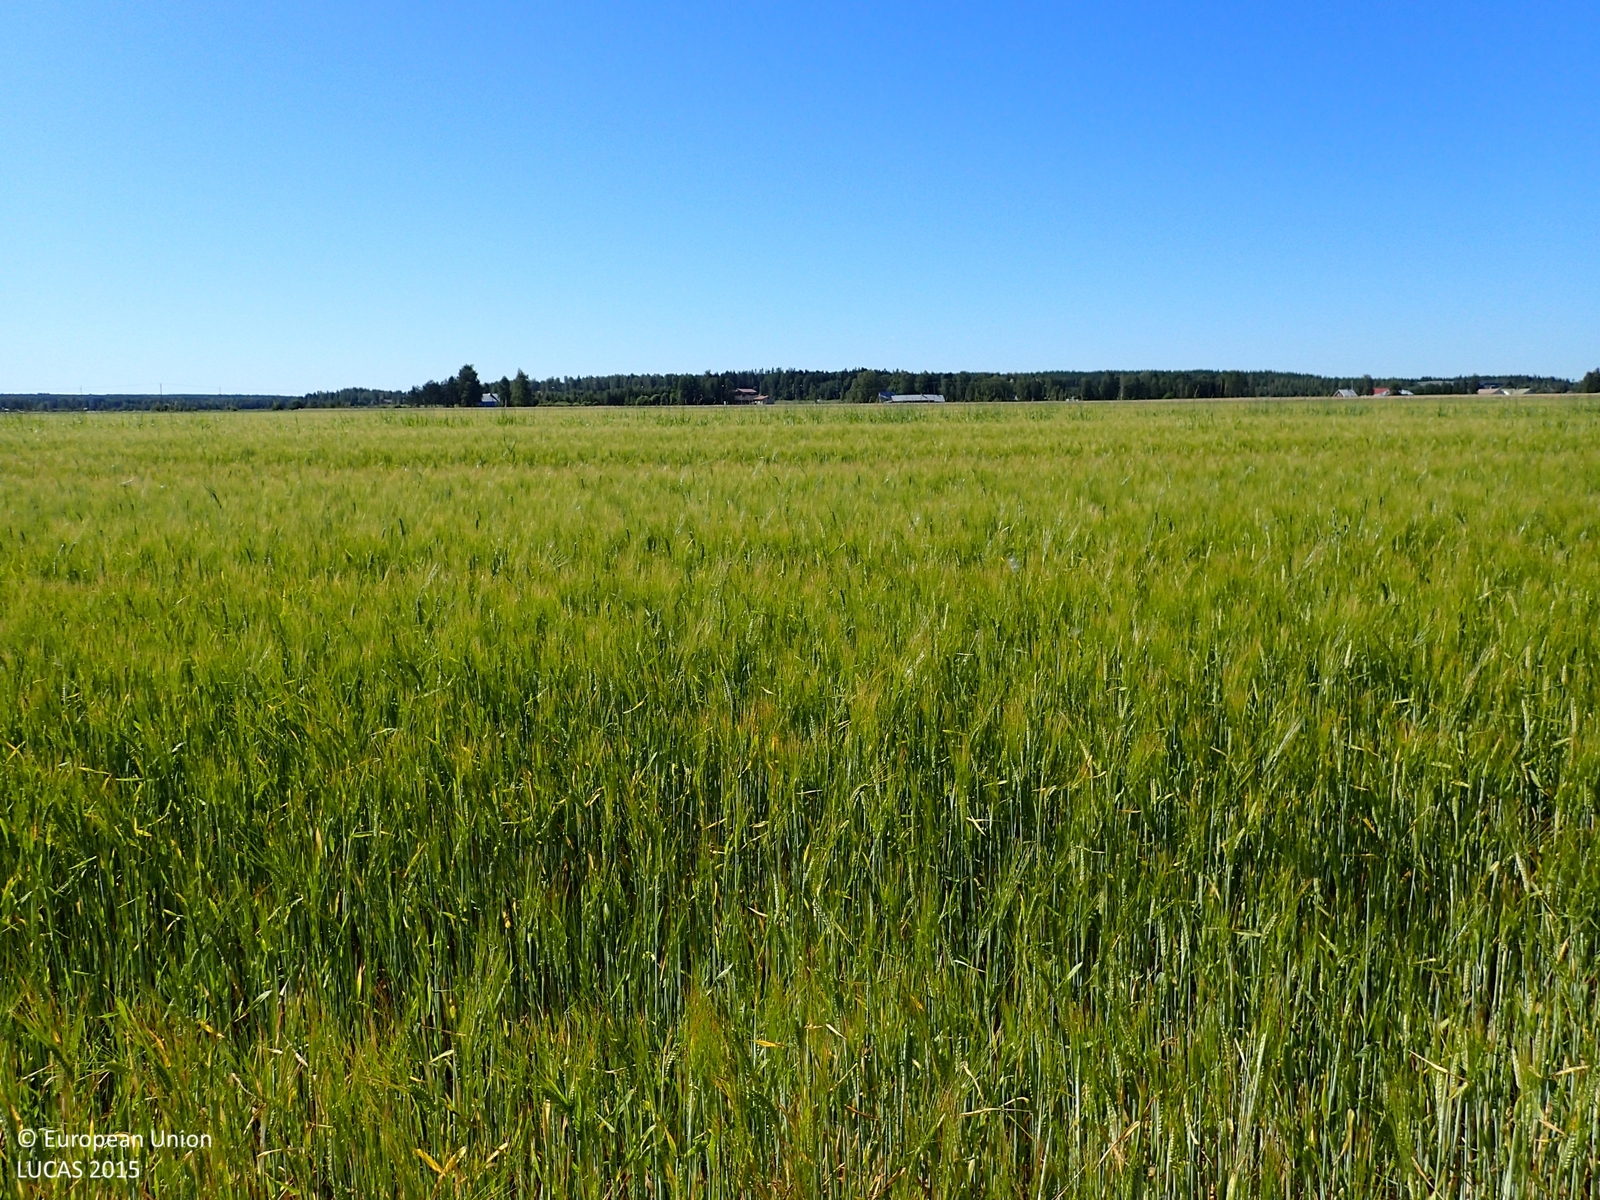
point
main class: Cropland
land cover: Barley
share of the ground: > 75 %
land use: Agriculture (excluding fallow land and kitchen gardens)
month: August
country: FI
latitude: 62.6013
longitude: 22.5018
